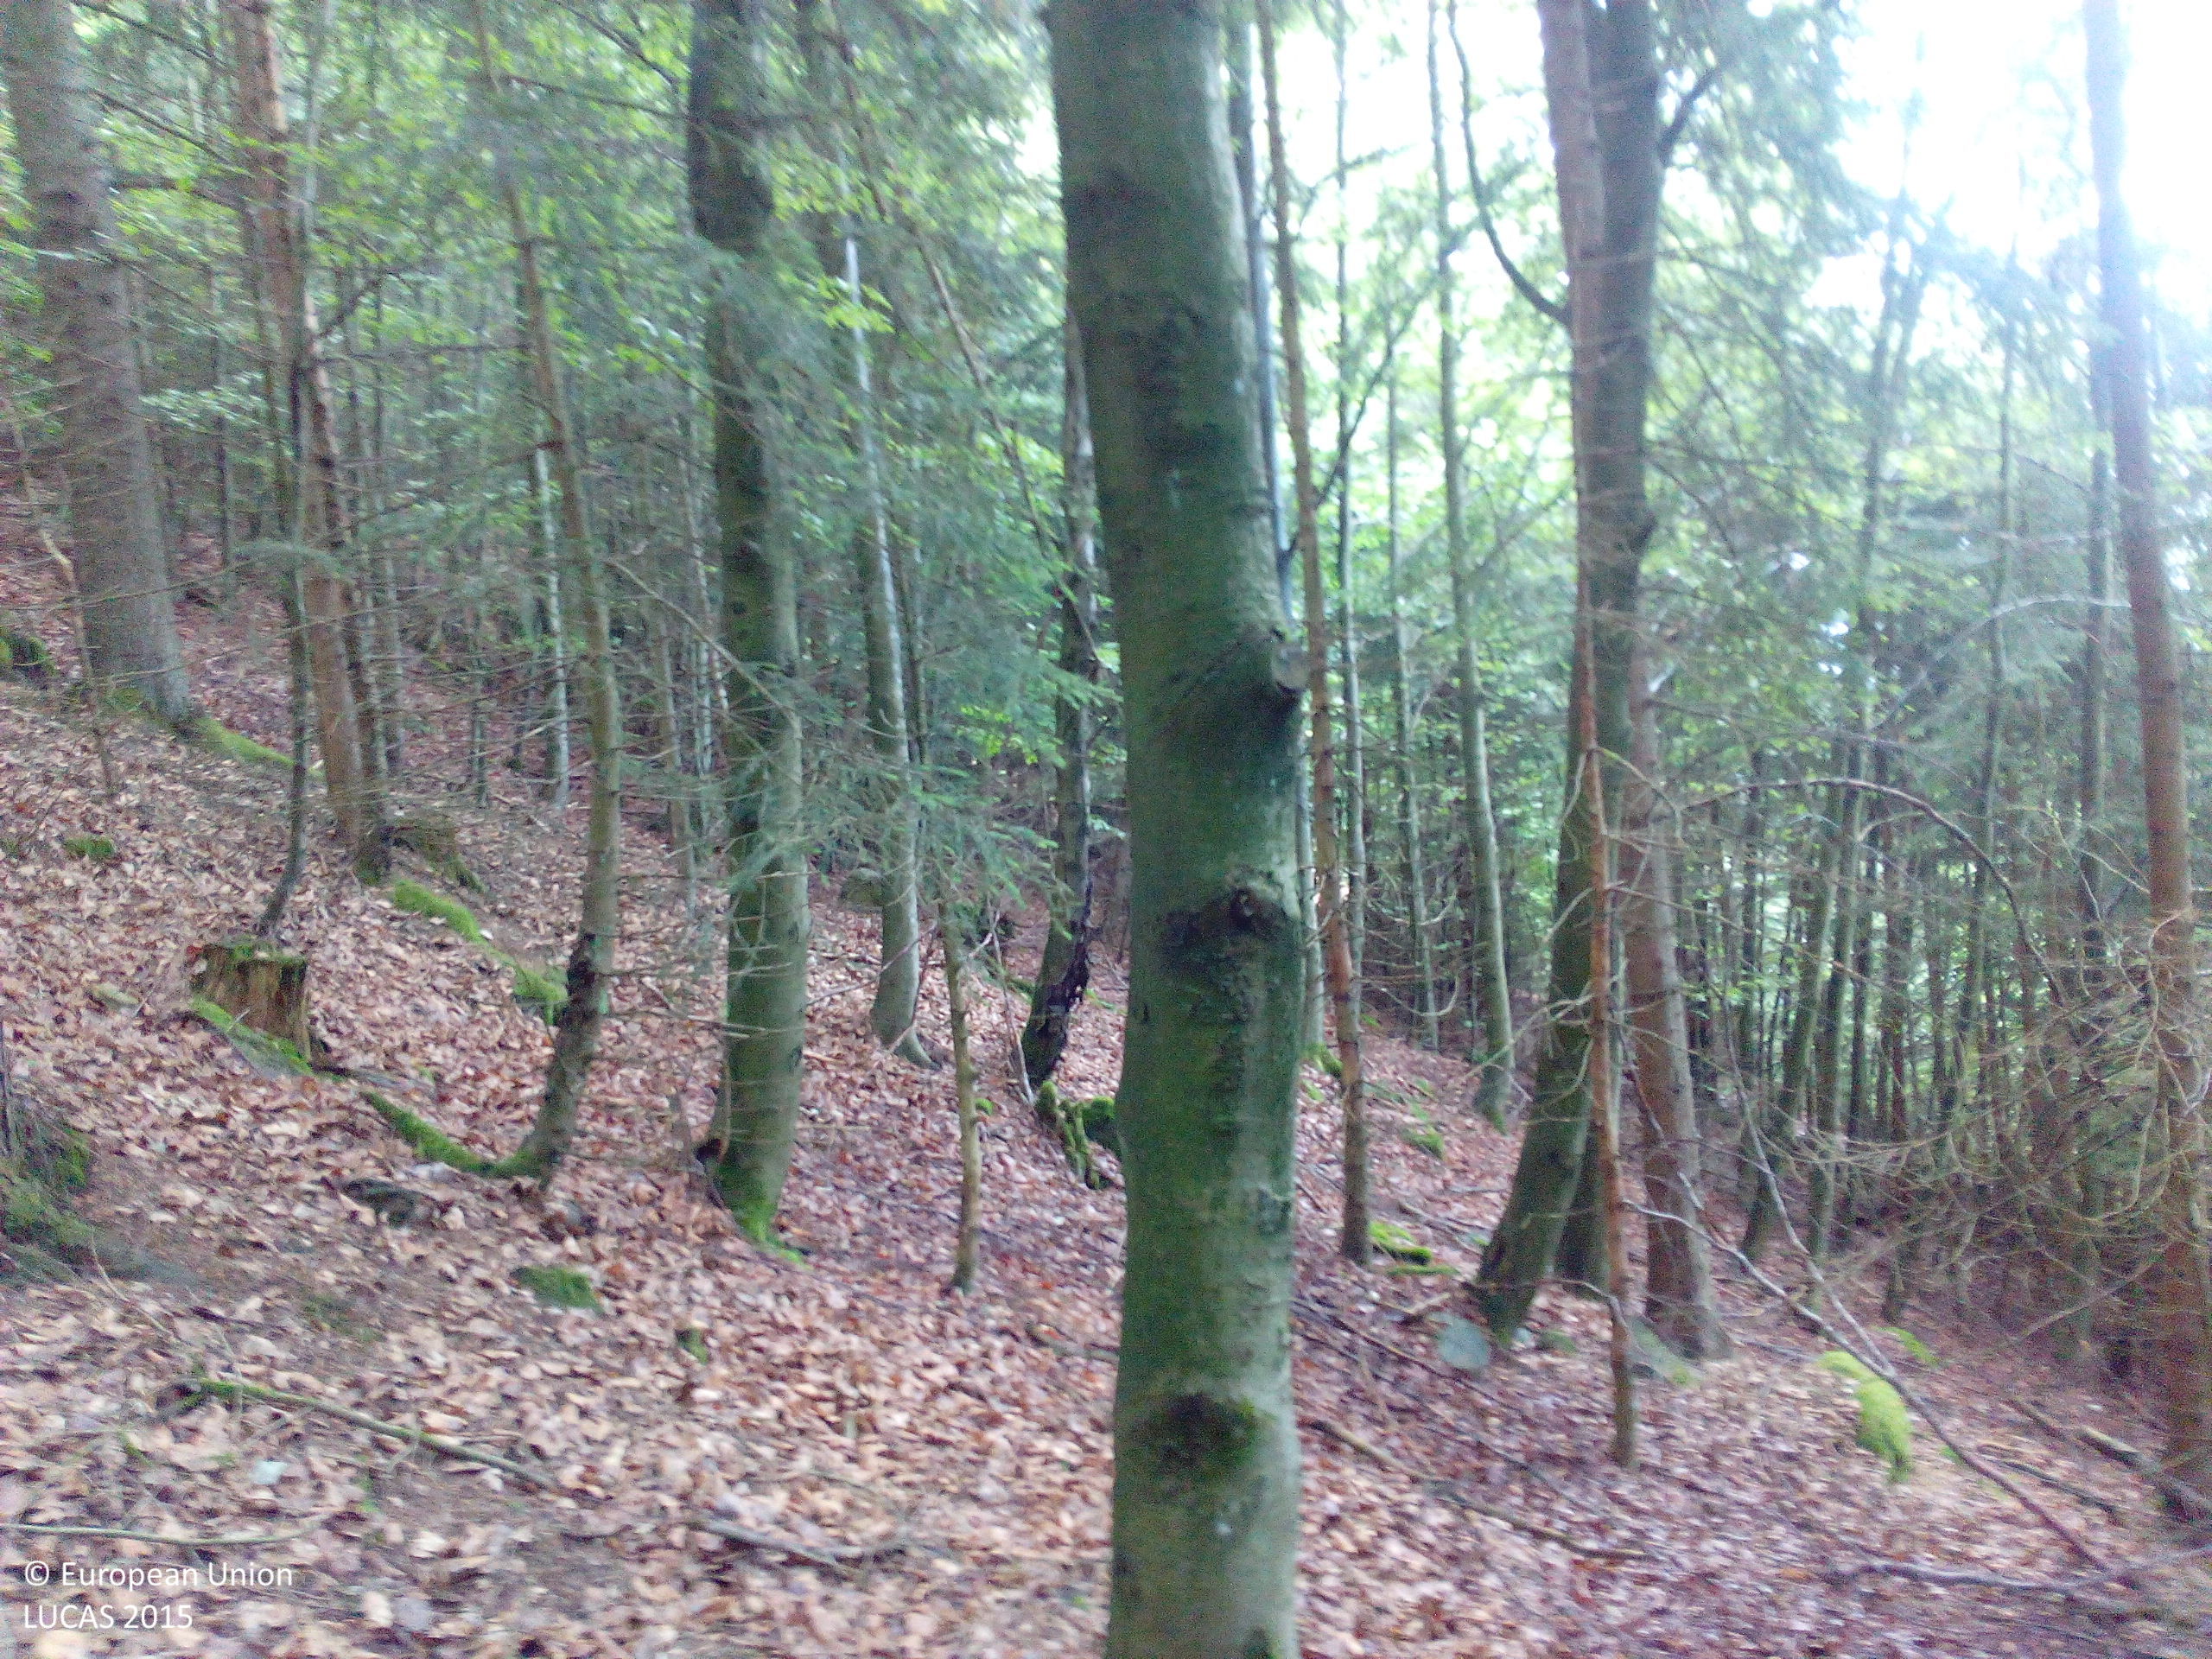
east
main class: Woodland
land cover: Spruce dominated mixed woodland
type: hemiboreal forest and nemoral coniferous forest and mixed broadleaved-coniferous forest
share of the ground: > 75 %
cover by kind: coniferous forest trees 60 %, broadleaved forest trees 25 %, unconsolidated bare surface 10 %, lichens and mosses 5 %
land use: Forestry
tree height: > 5 m
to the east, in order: Spruce dominated mixed woodland; Rocks and stones; Spruce dominated mixed woodland; Rocks and stones; Spruce dominated mixed woodland
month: July
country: DE
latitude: 49.1556
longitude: 12.9751
